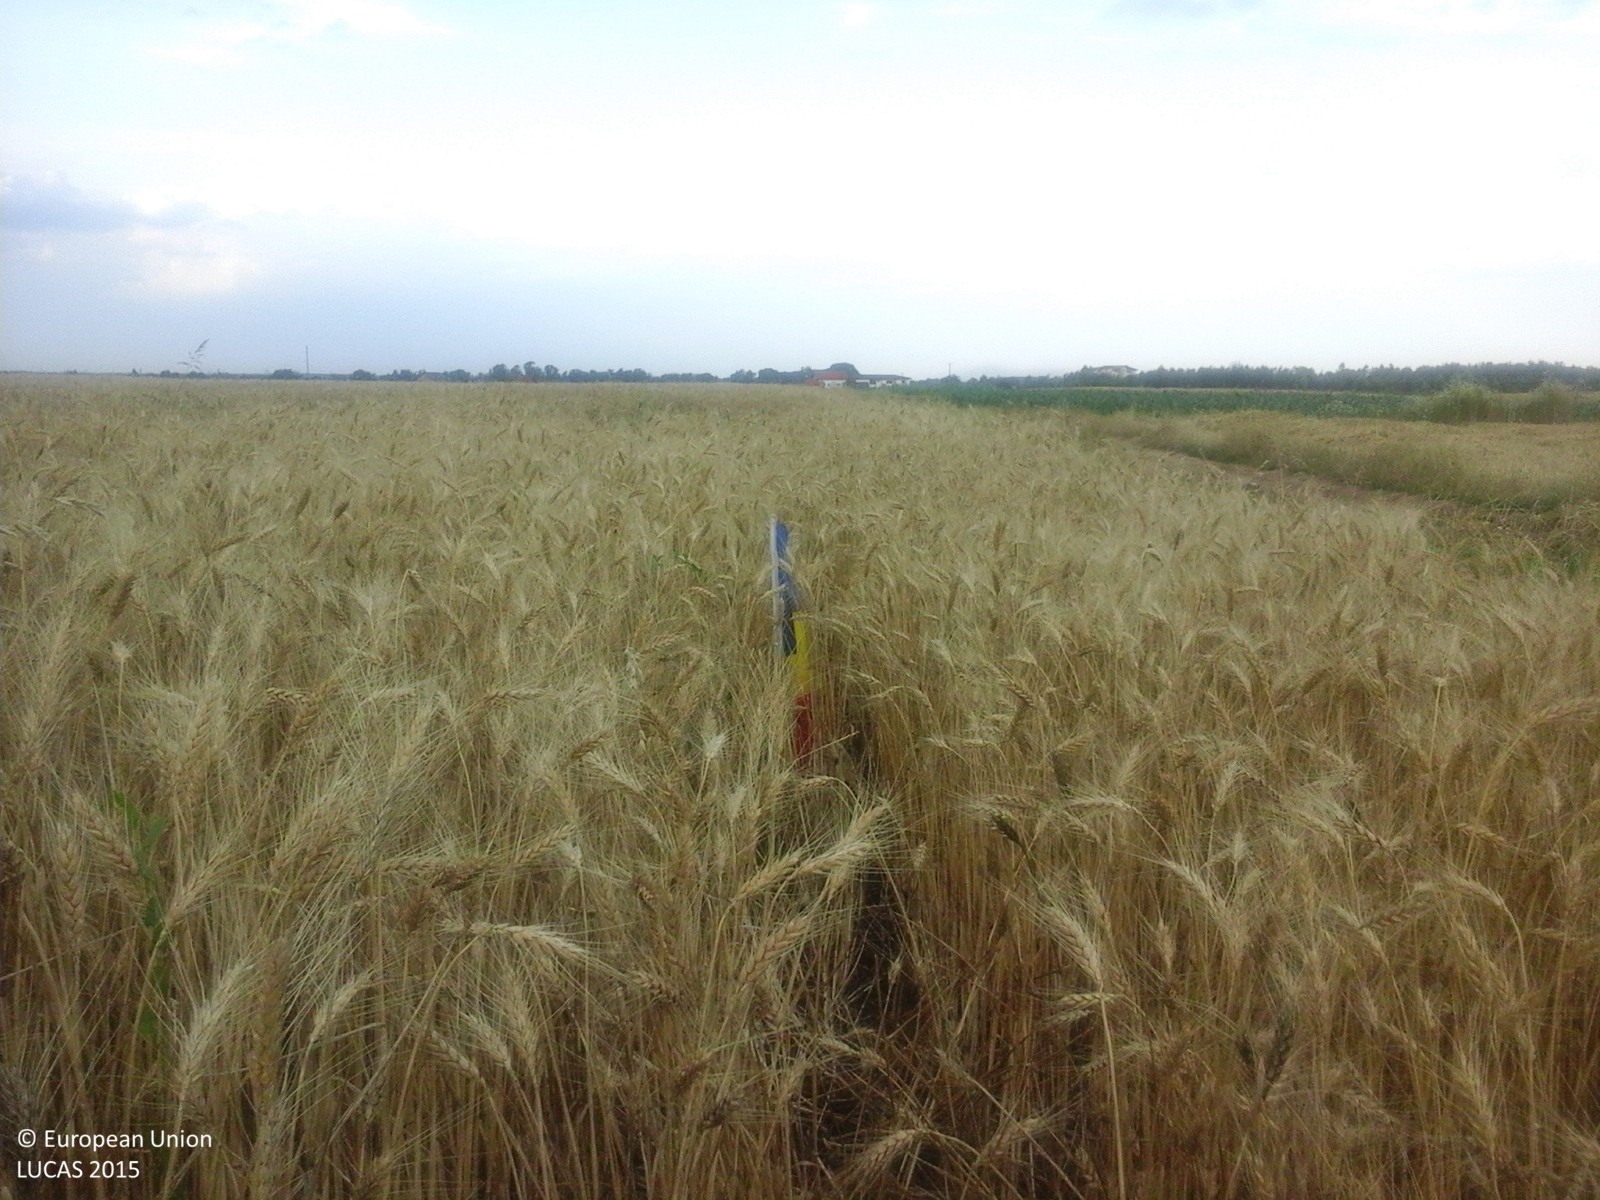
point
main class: Cropland
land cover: Common wheat
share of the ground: > 75 %
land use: Agriculture (excluding fallow land and kitchen gardens)
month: June
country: RO
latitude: 44.2704
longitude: 26.0246
